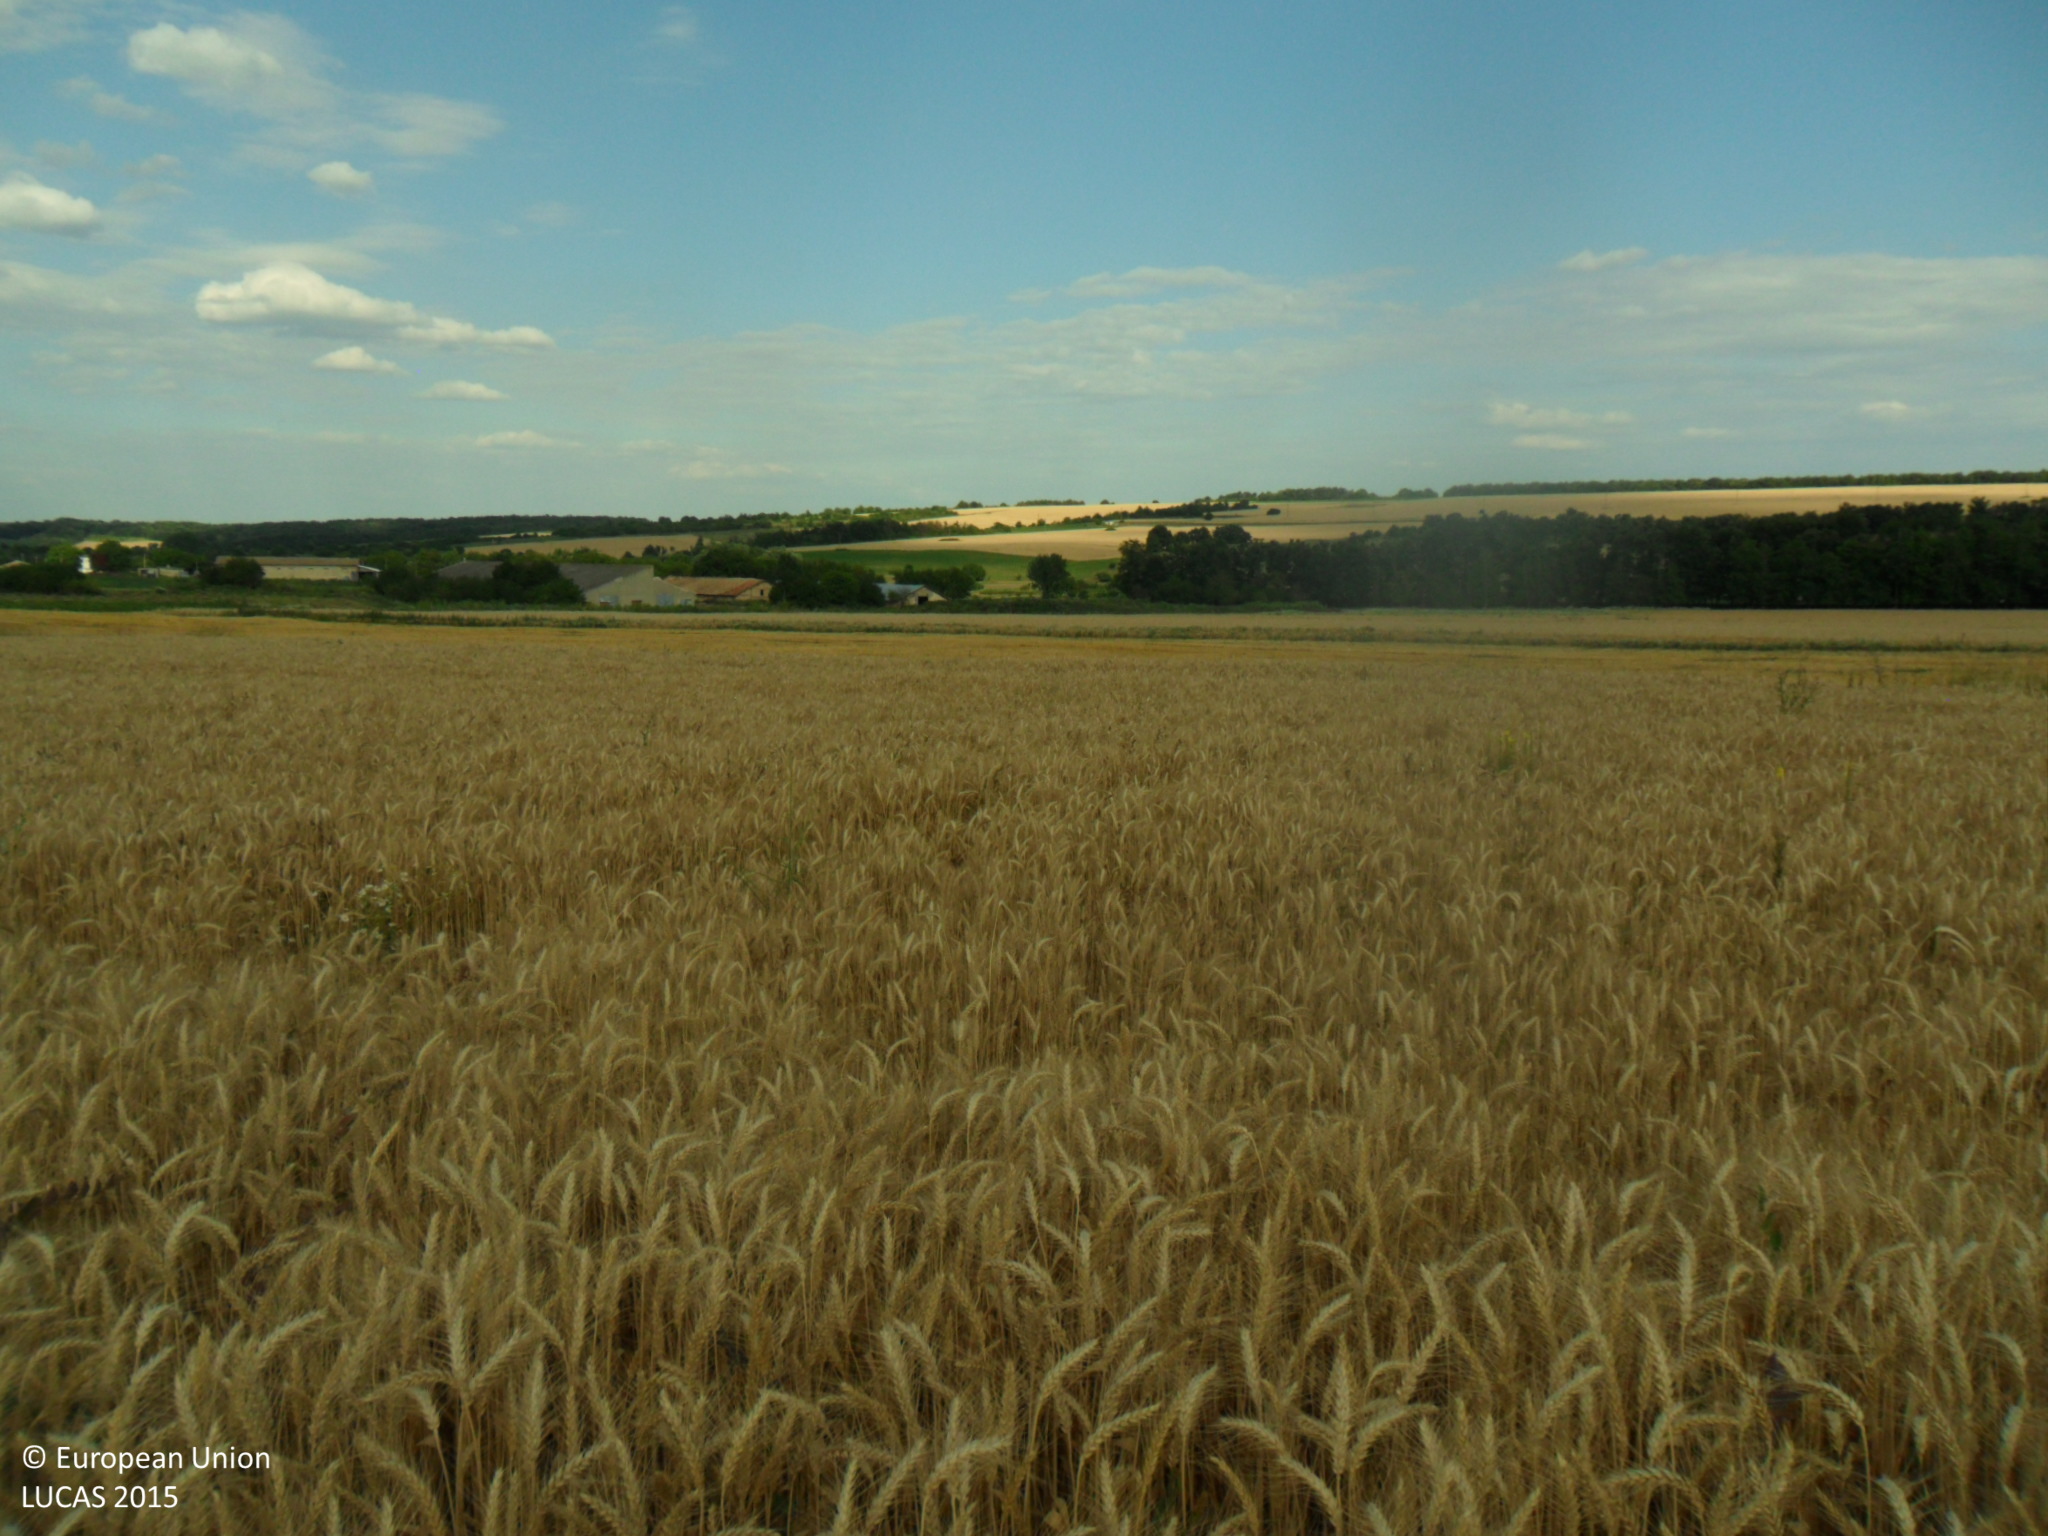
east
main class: Cropland
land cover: Common wheat
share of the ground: > 75 %
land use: Agriculture (excluding fallow land and kitchen gardens)
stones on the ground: < 10 %
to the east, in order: Common wheat; Grass margins; Barley; Grass margins; Tracks; Shrubland without tree cover; Barley
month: June
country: BG
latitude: 43.5305
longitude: 27.2879
